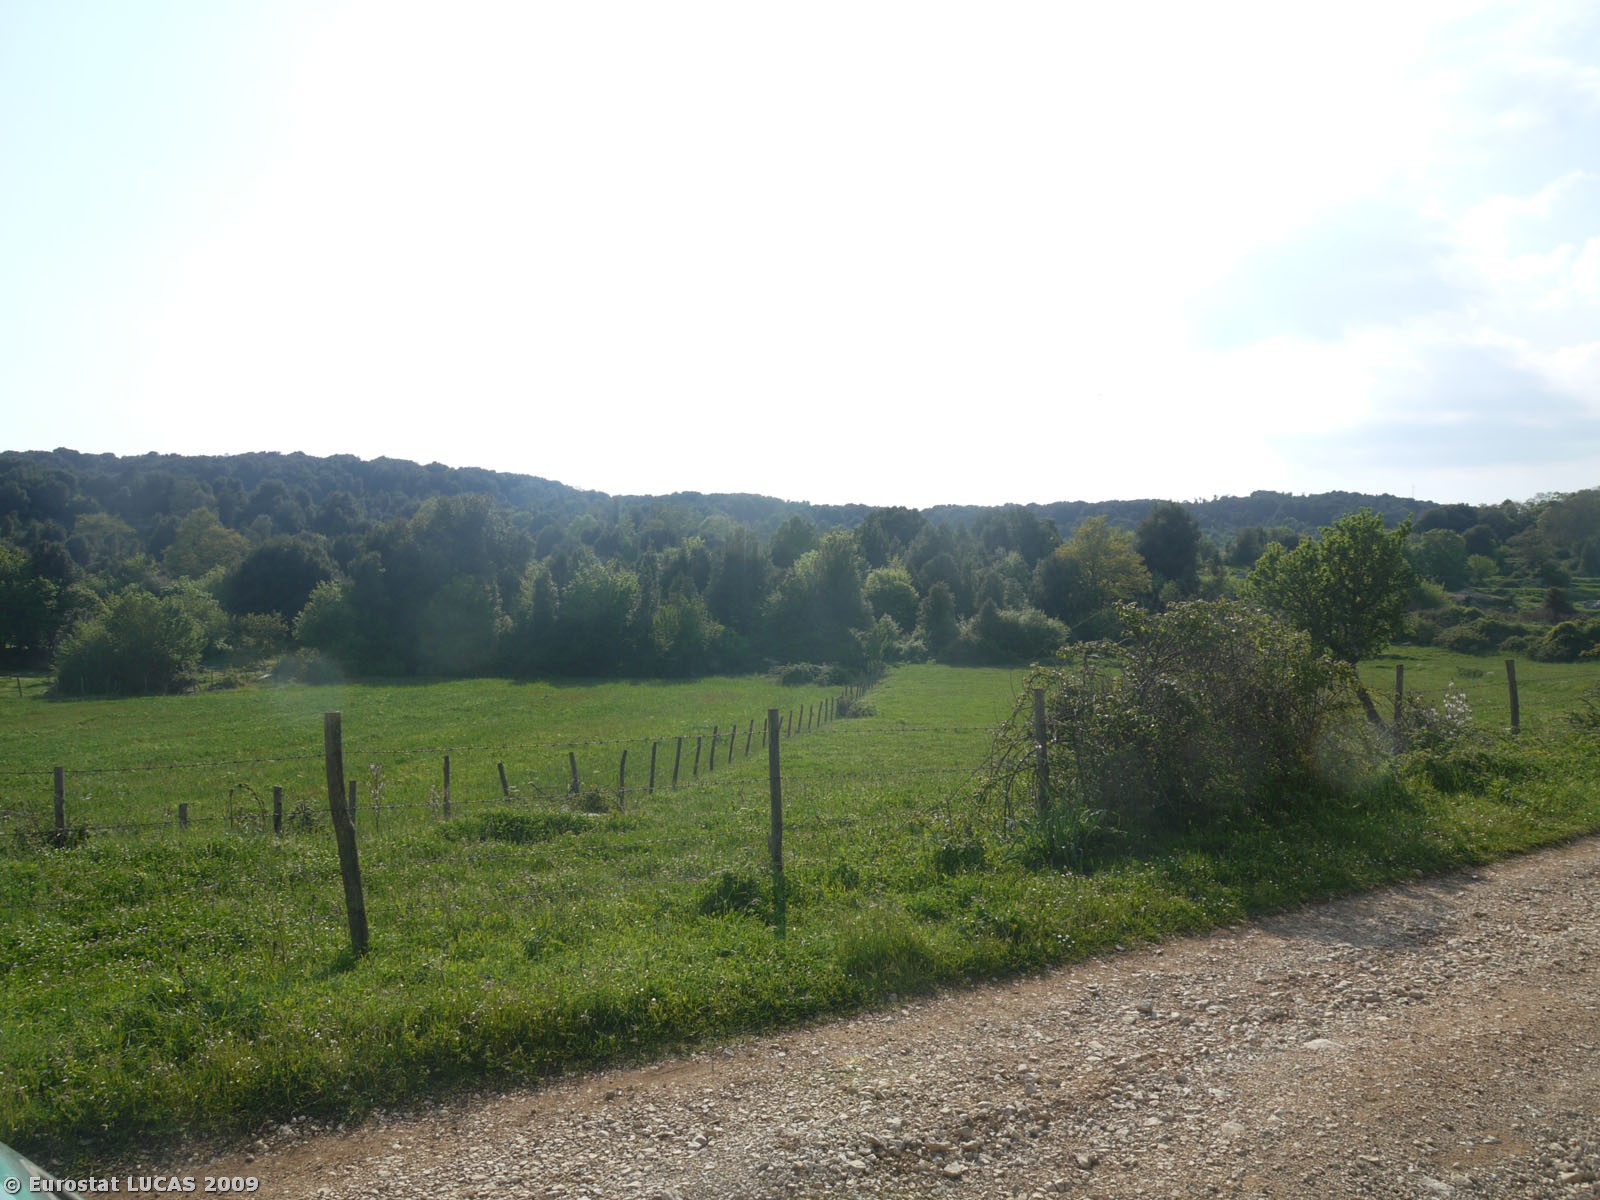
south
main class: Woodland
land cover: Broadleaved woodland
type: broadleaved evergreen forest
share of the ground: > 75 %
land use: Agriculture (excluding fallow land and kitchen gardens)
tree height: > 5 m
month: May
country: IT
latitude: 41.4444
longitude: 13.2548
